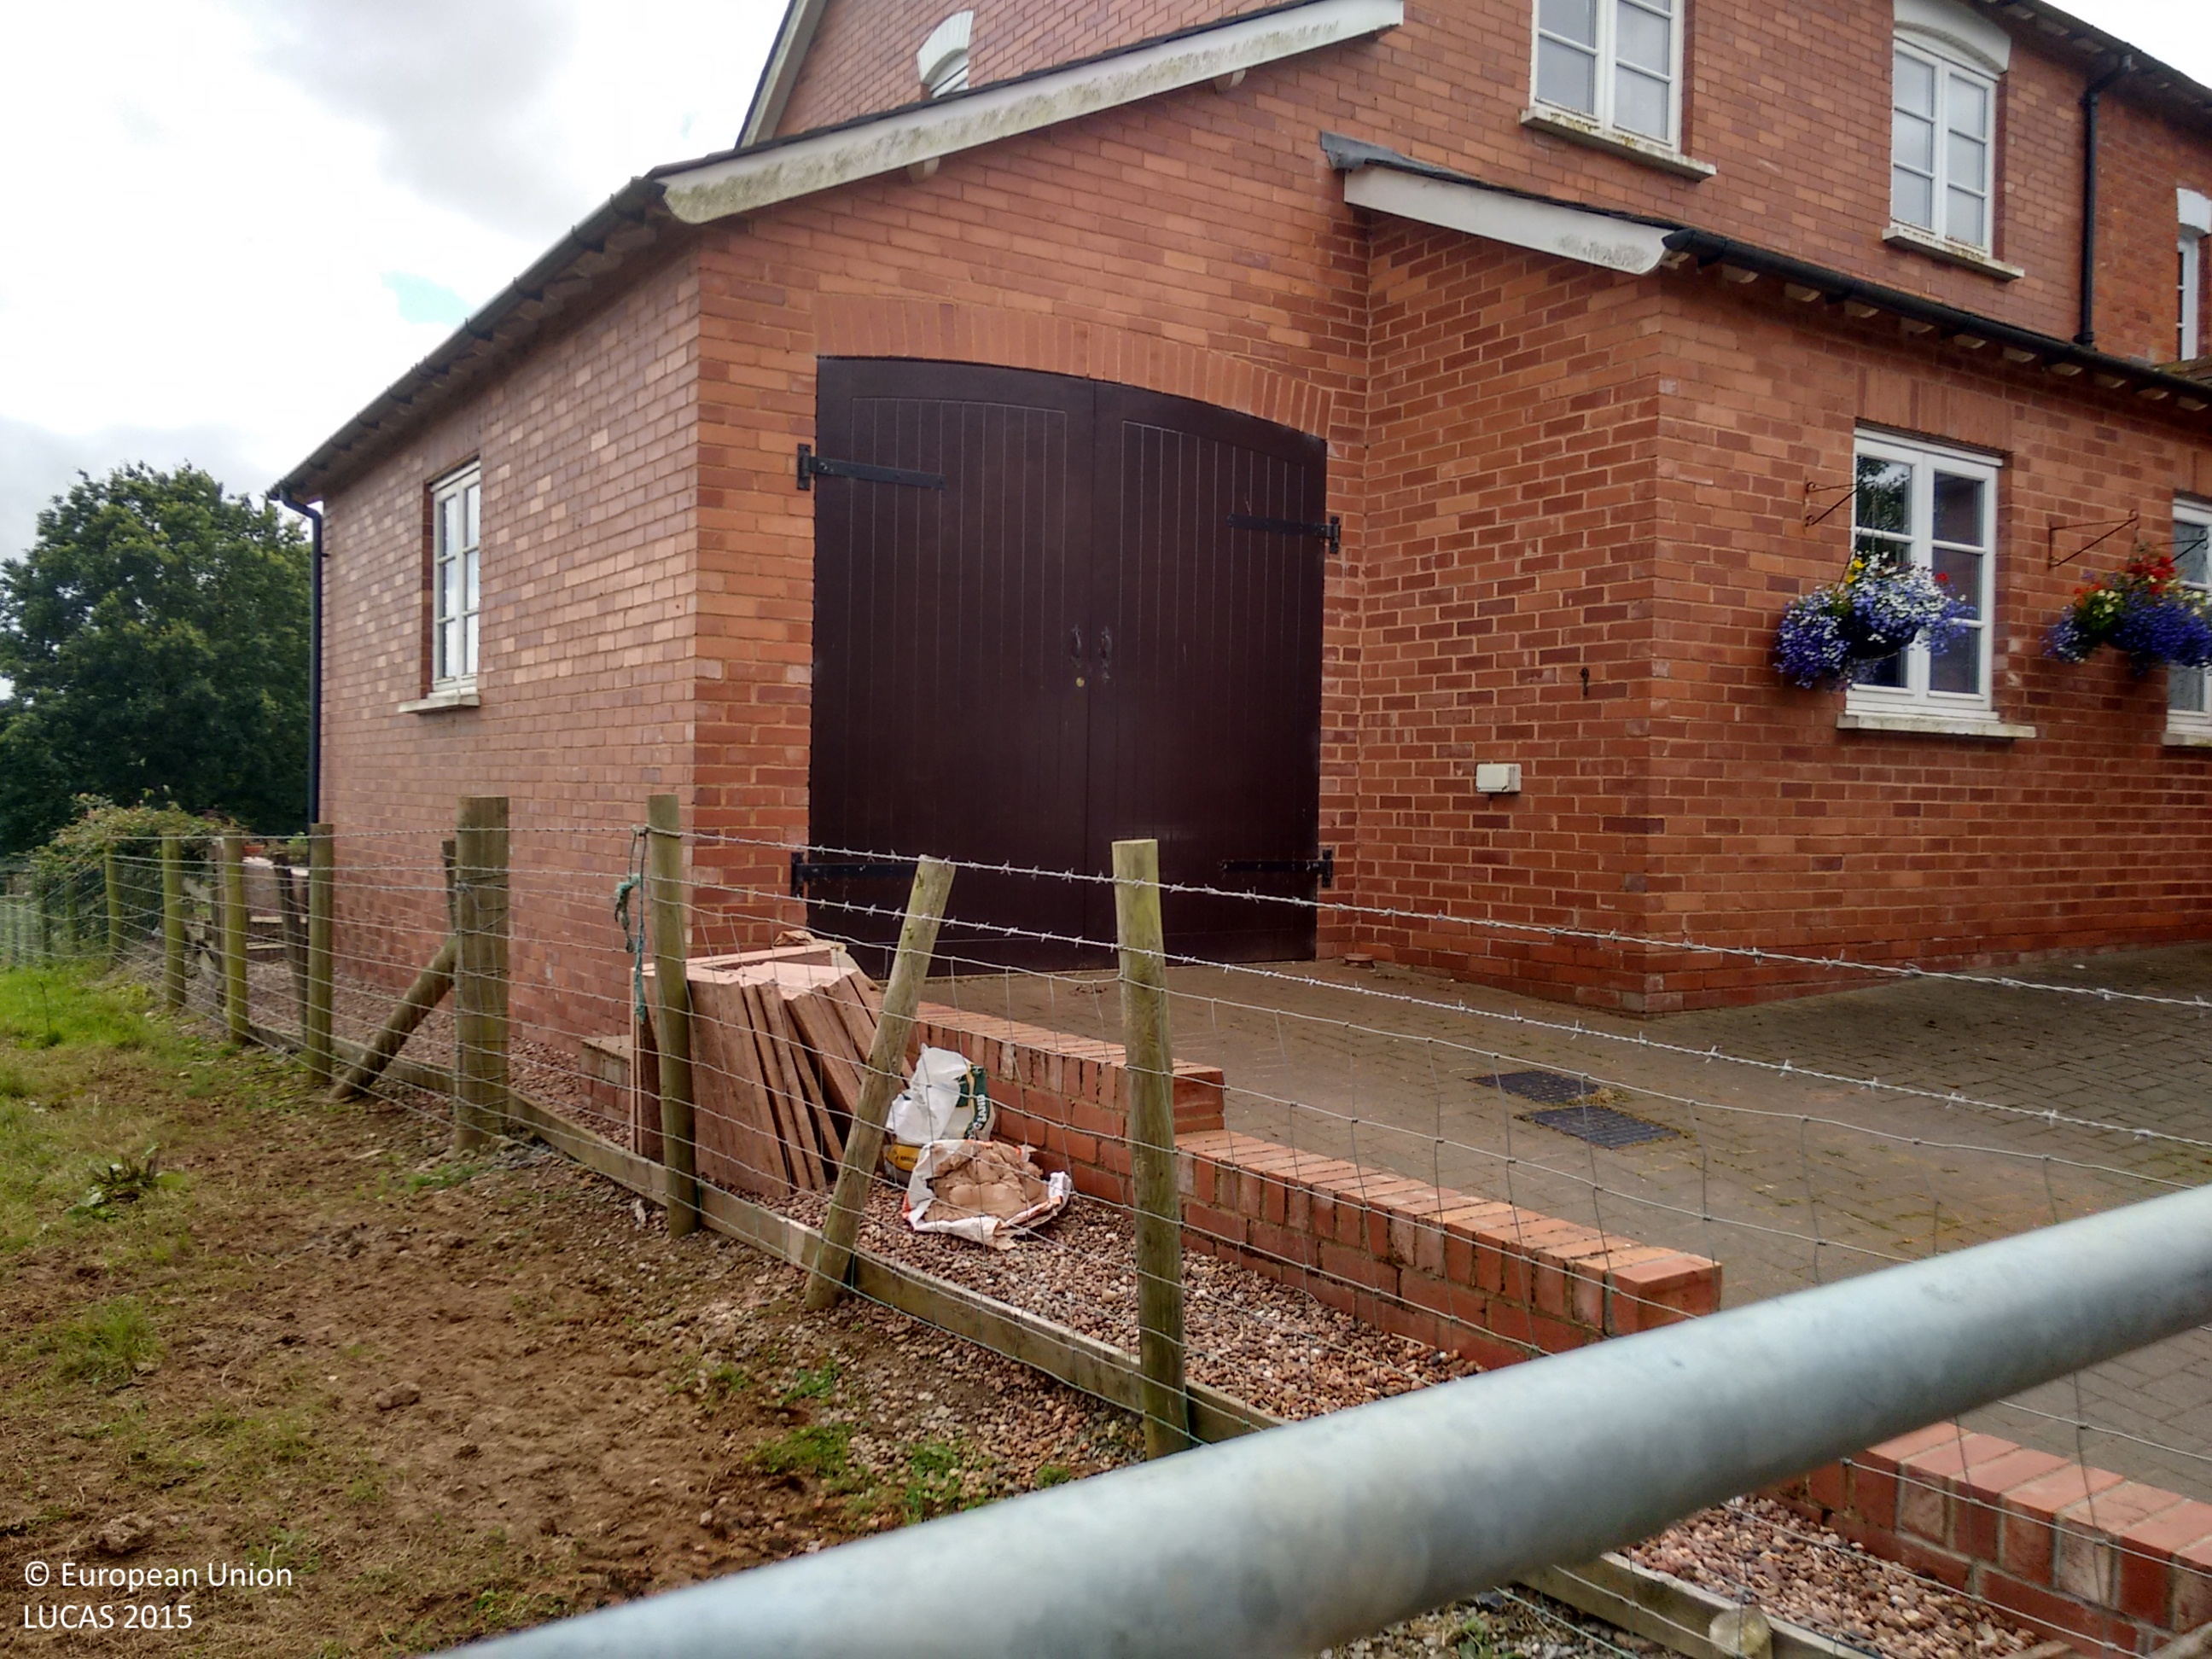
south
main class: Grassland
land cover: Grassland without tree/shrub cover
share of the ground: > 75 %
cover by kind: herbaceous plants 100 %
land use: Agriculture (excluding fallow land and kitchen gardens)
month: August
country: GB
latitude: 50.7701
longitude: -3.7437
